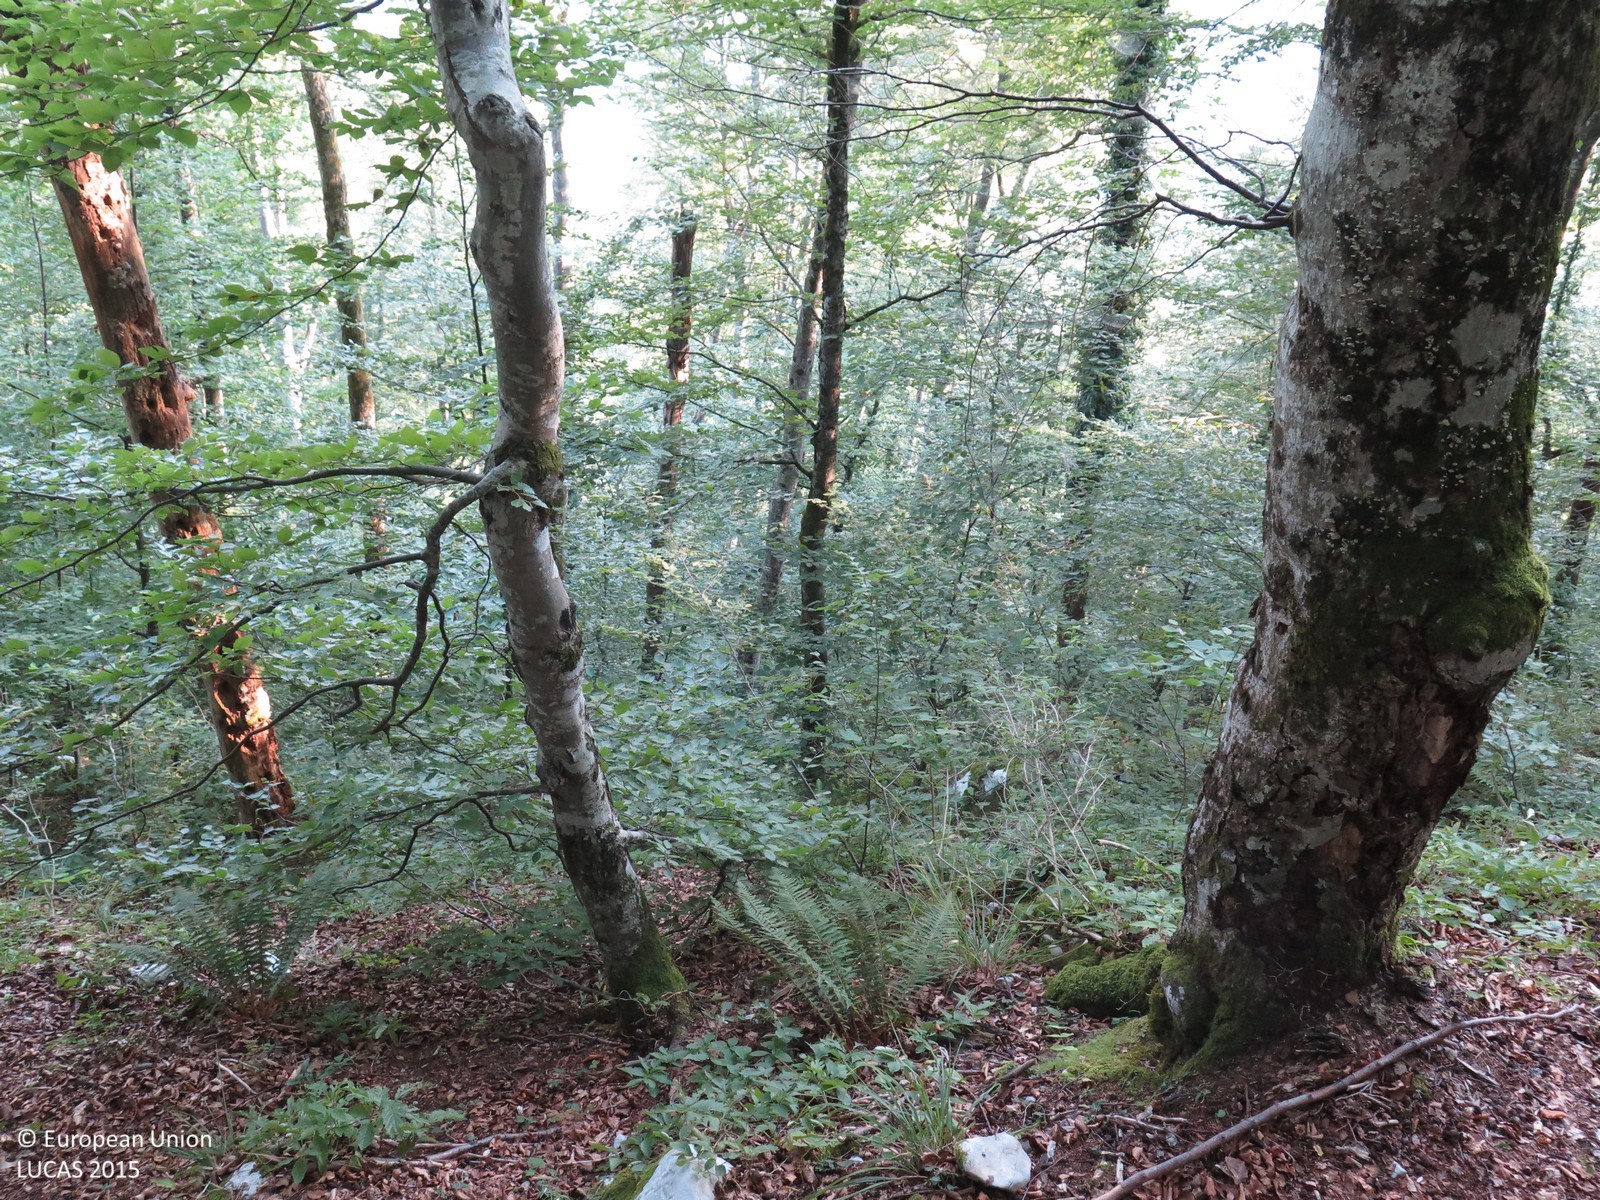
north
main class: Woodland
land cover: Broadleaved woodland
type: mountainous beech forest
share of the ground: > 75 %
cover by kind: broadleaved forest trees 90 %, herbaceous plants 5 %, unconsolidated bare surface 5 %
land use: Forestry
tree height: > 5 m
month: August
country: HR
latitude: 45.4943
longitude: 14.9990
